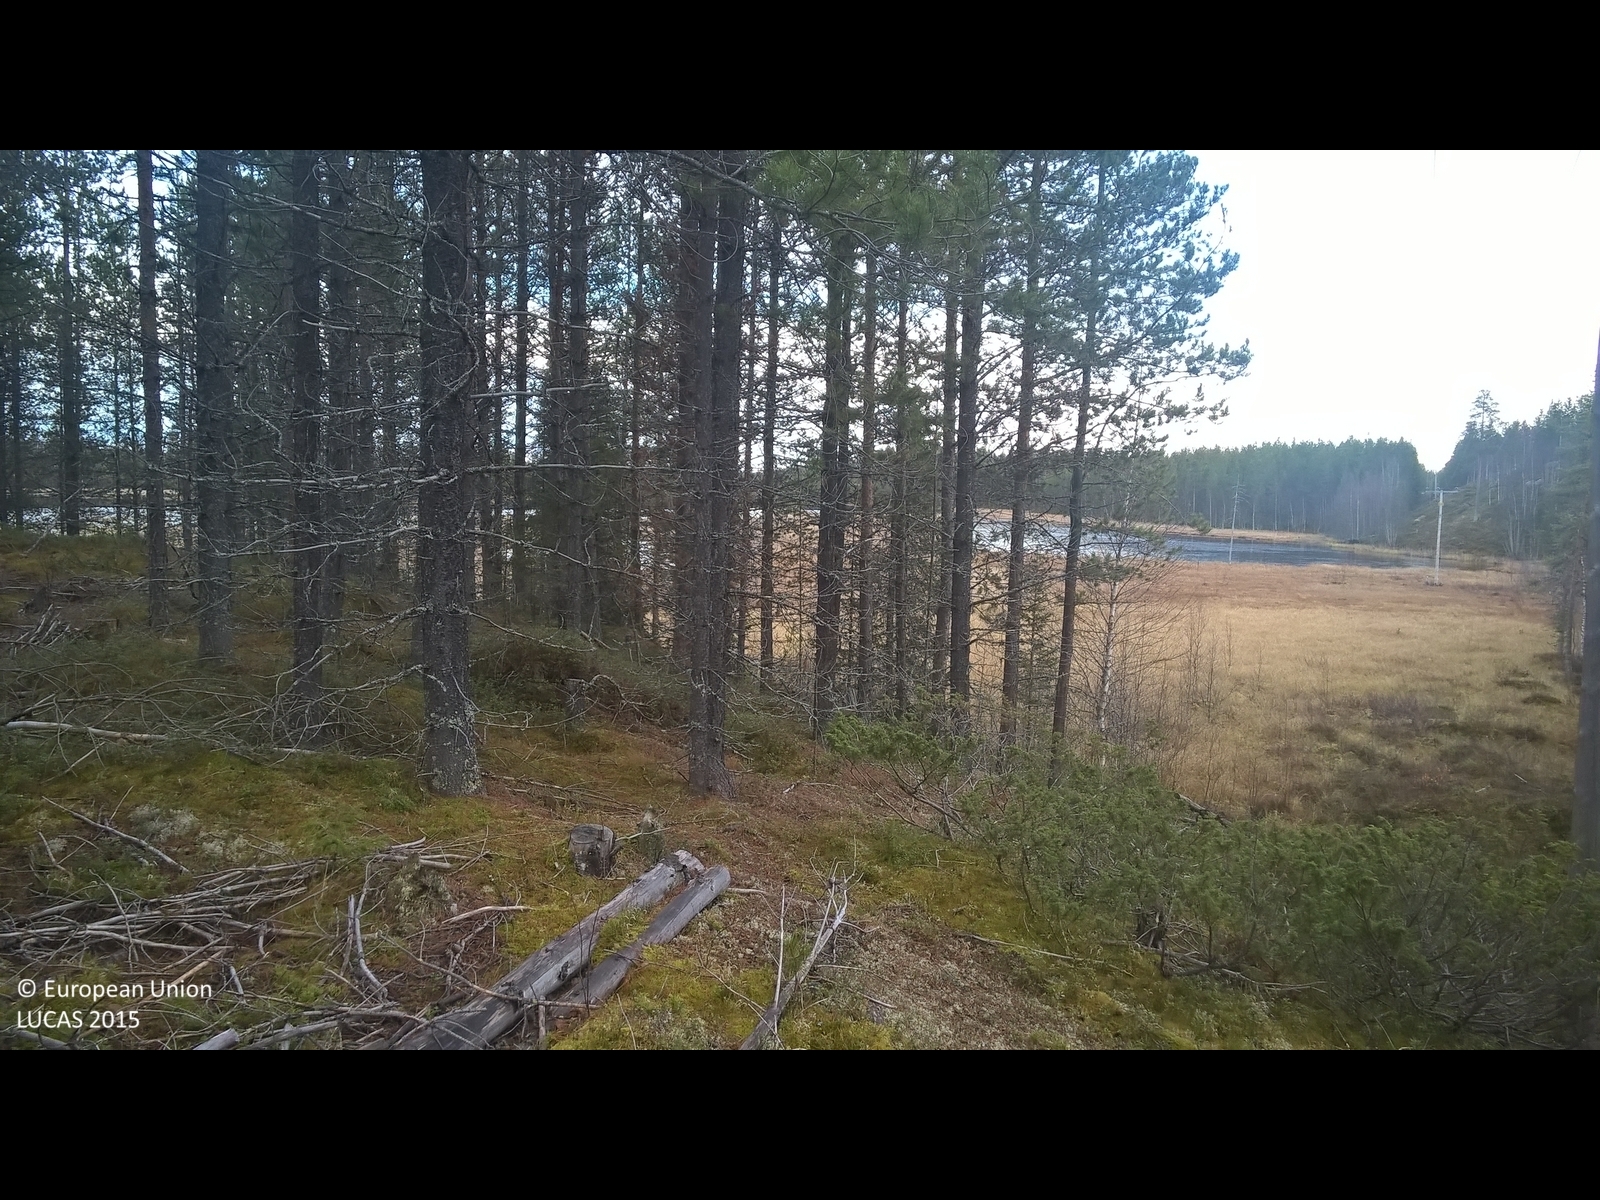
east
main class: Shrubland
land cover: Shrubland without tree cover
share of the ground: > 75 %
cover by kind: shrubs 50 %, herbaceous plants 50 %
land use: Electricity, gas and thermal power distribution
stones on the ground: < 10 %
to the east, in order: Shrubland without tree cover; Pine dominated coniferous woodland; Inland marshes; Inland fresh water bodies
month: October
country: SE
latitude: 65.2011
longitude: 17.8893
